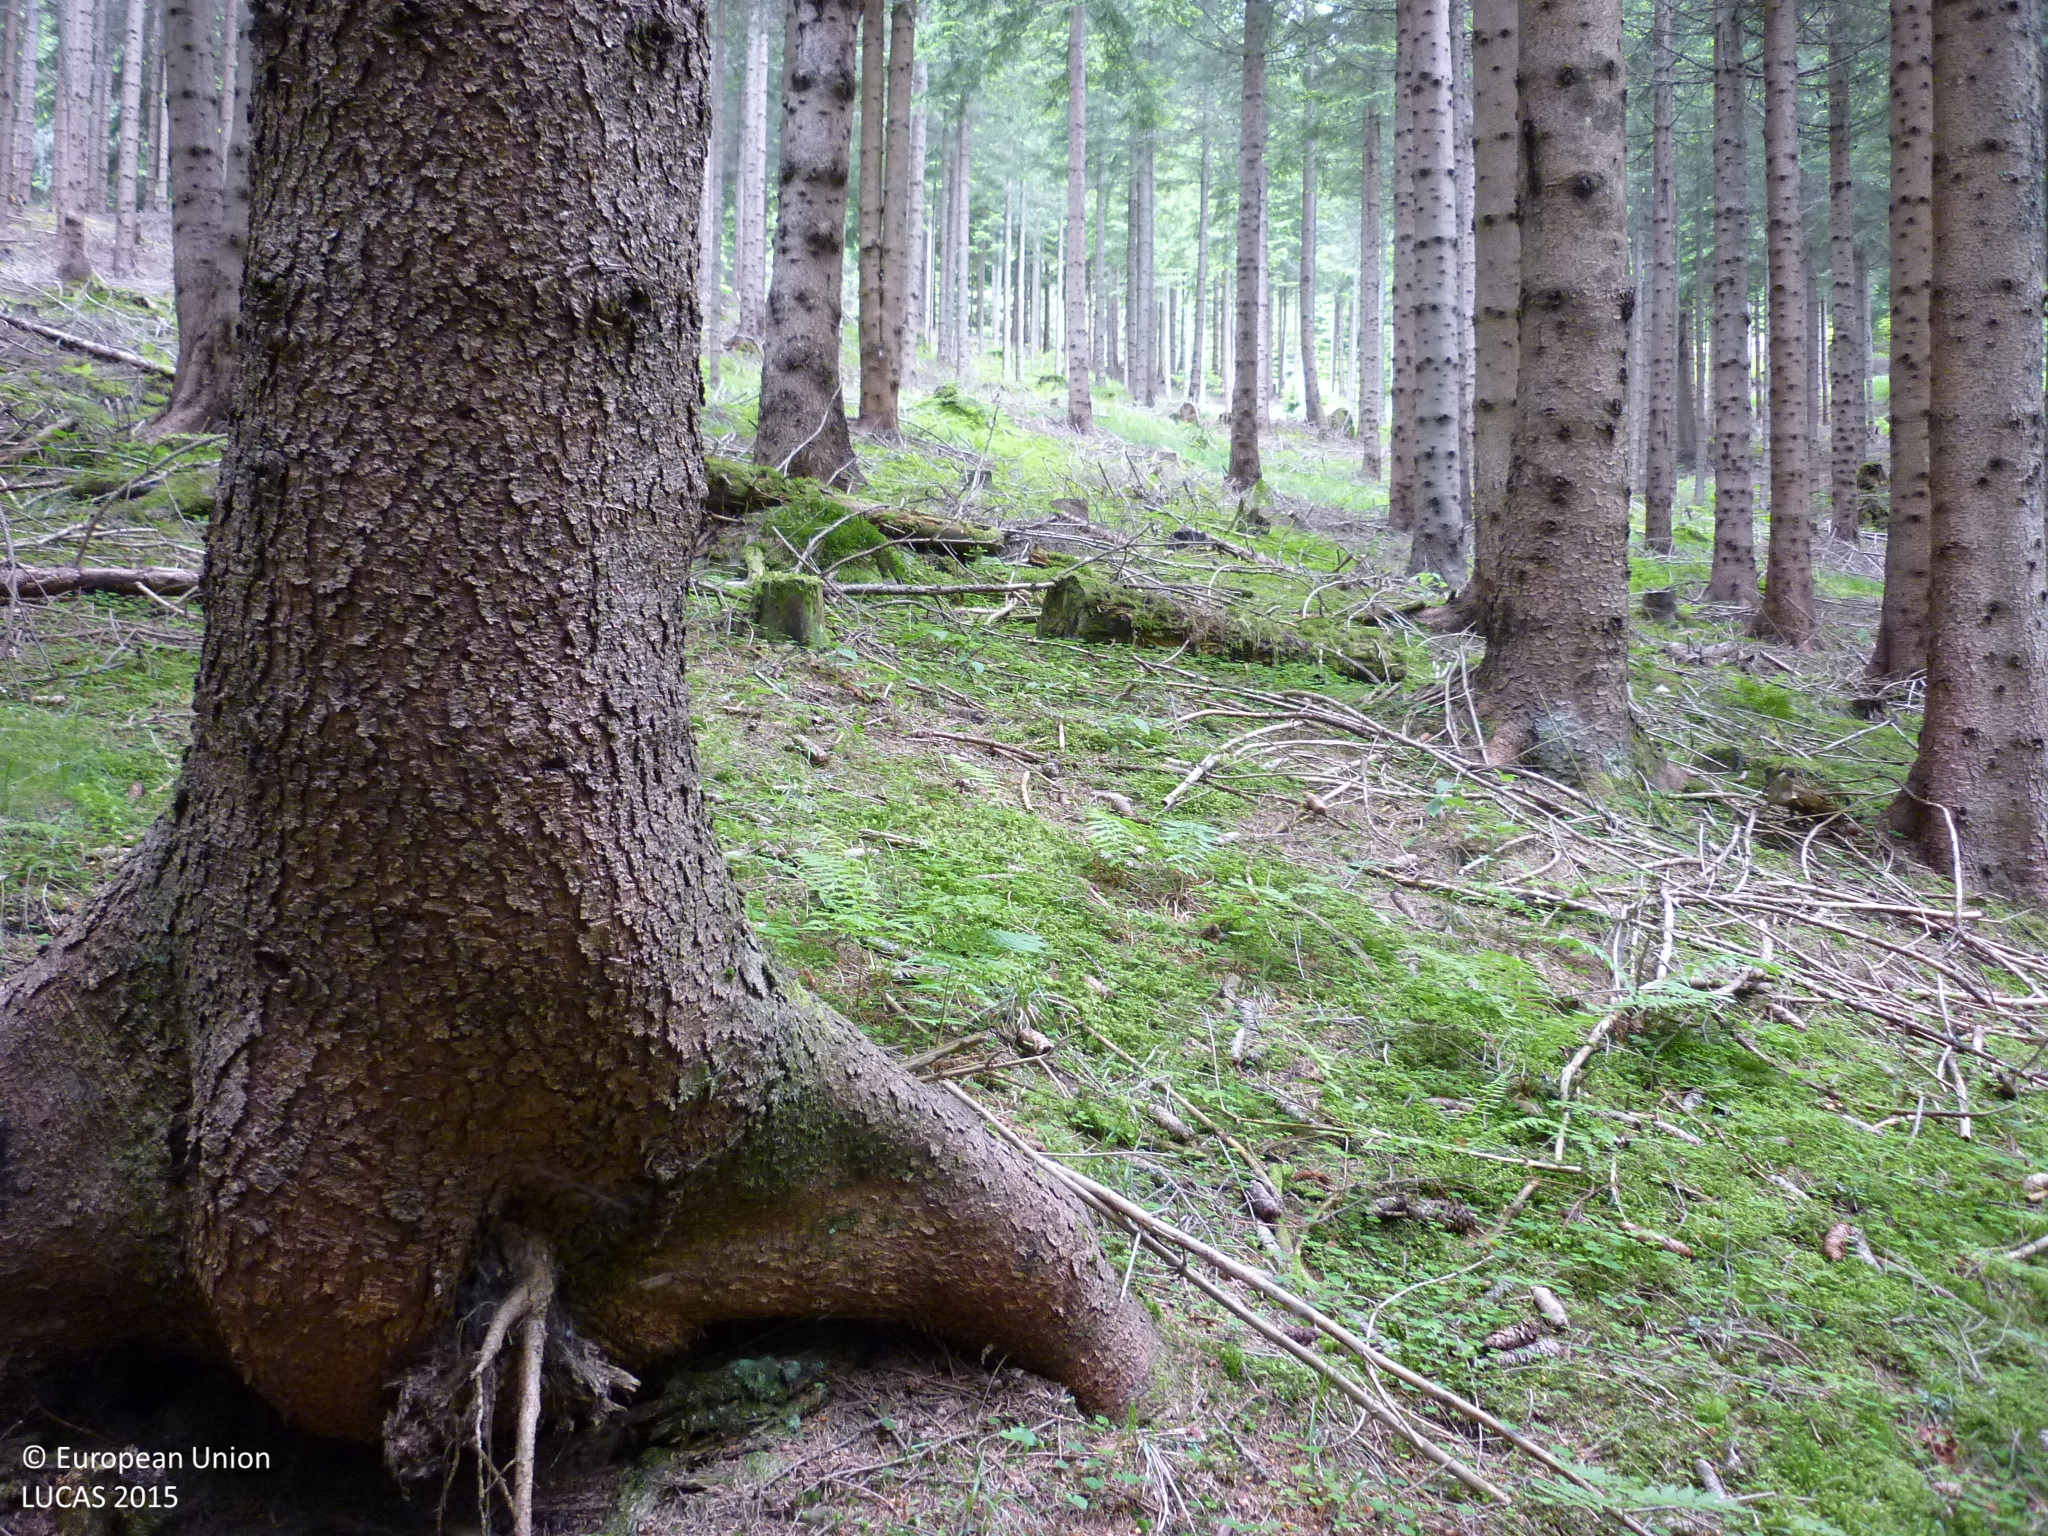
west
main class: Woodland
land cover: Spruce dominated coniferous woodland
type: alpine coniferous forest
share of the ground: > 75 %
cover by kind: coniferous forest trees 100 %
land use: Forestry
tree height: > 5 m
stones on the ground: < 10 %
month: June
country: AT
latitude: 47.2578
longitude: 14.2669
